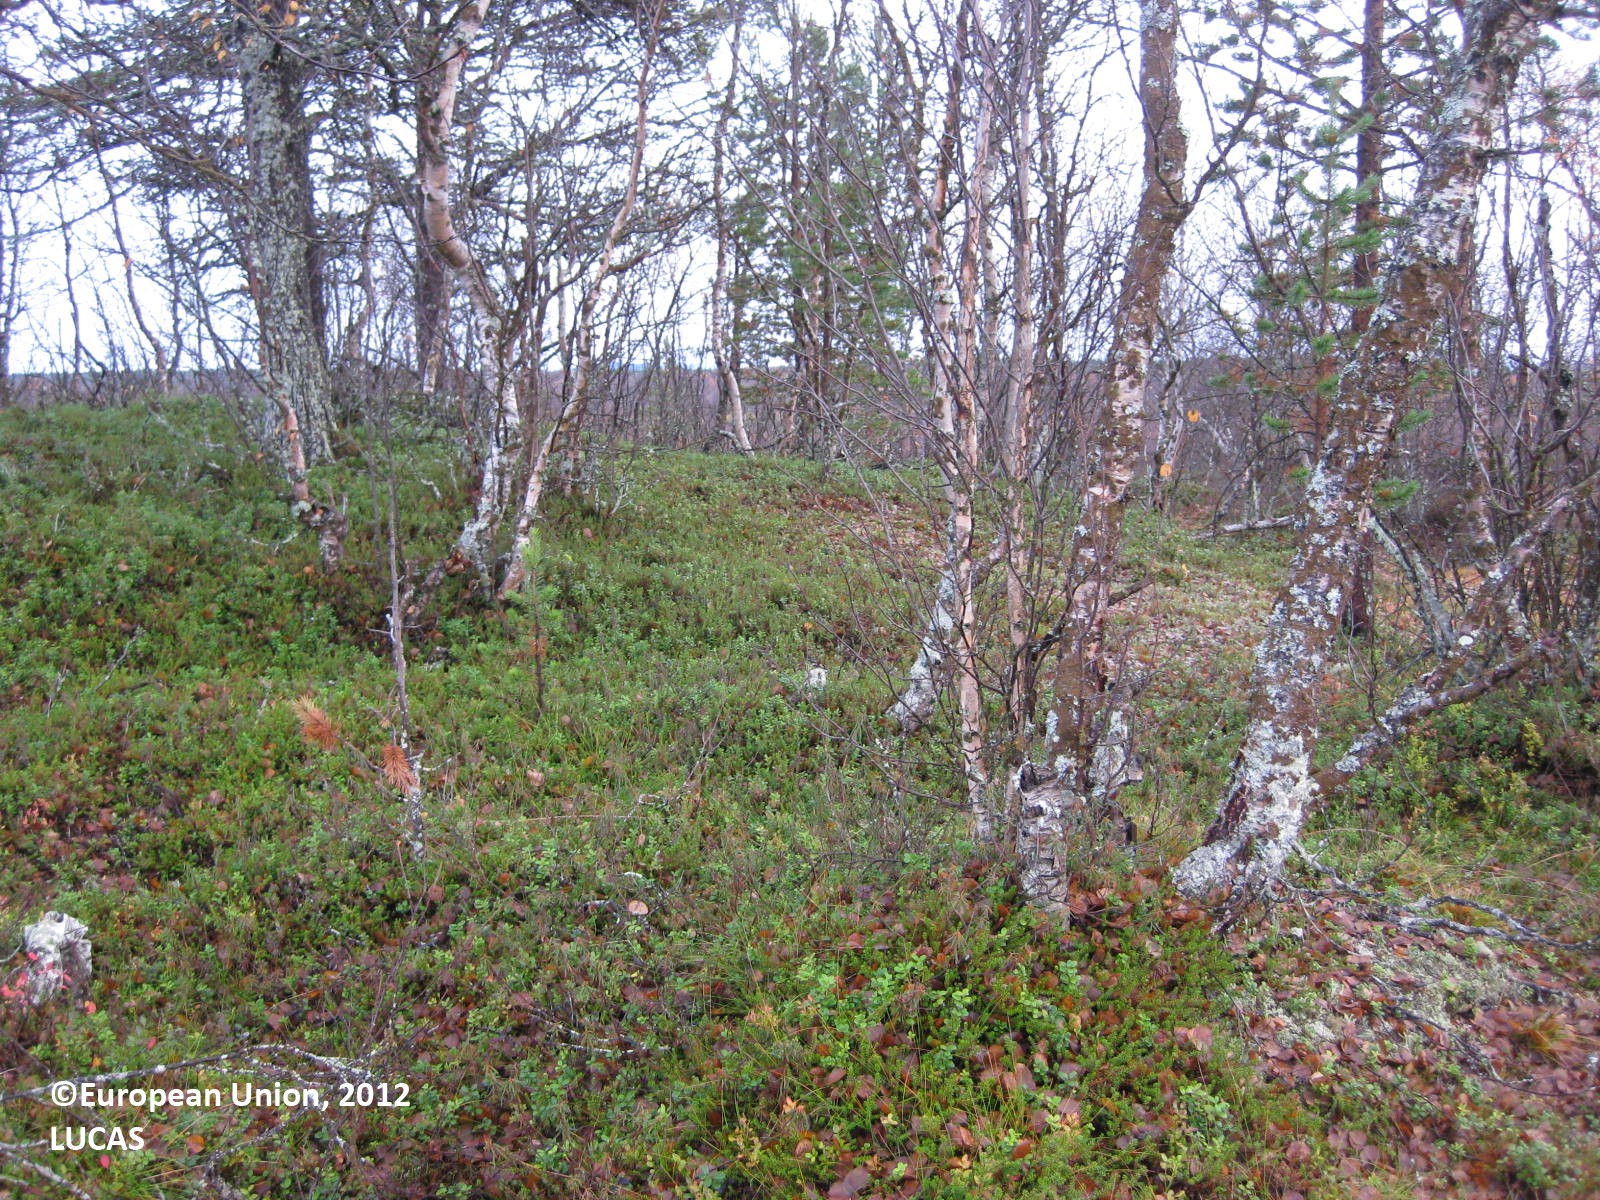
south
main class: Woodland
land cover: Broadleaved woodland
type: boreal forest
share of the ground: 25 - 50 %
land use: Agriculture (excluding fallow land and kitchen gardens)
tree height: > 5 m
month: September
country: FI
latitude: 68.4397
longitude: 24.0308
